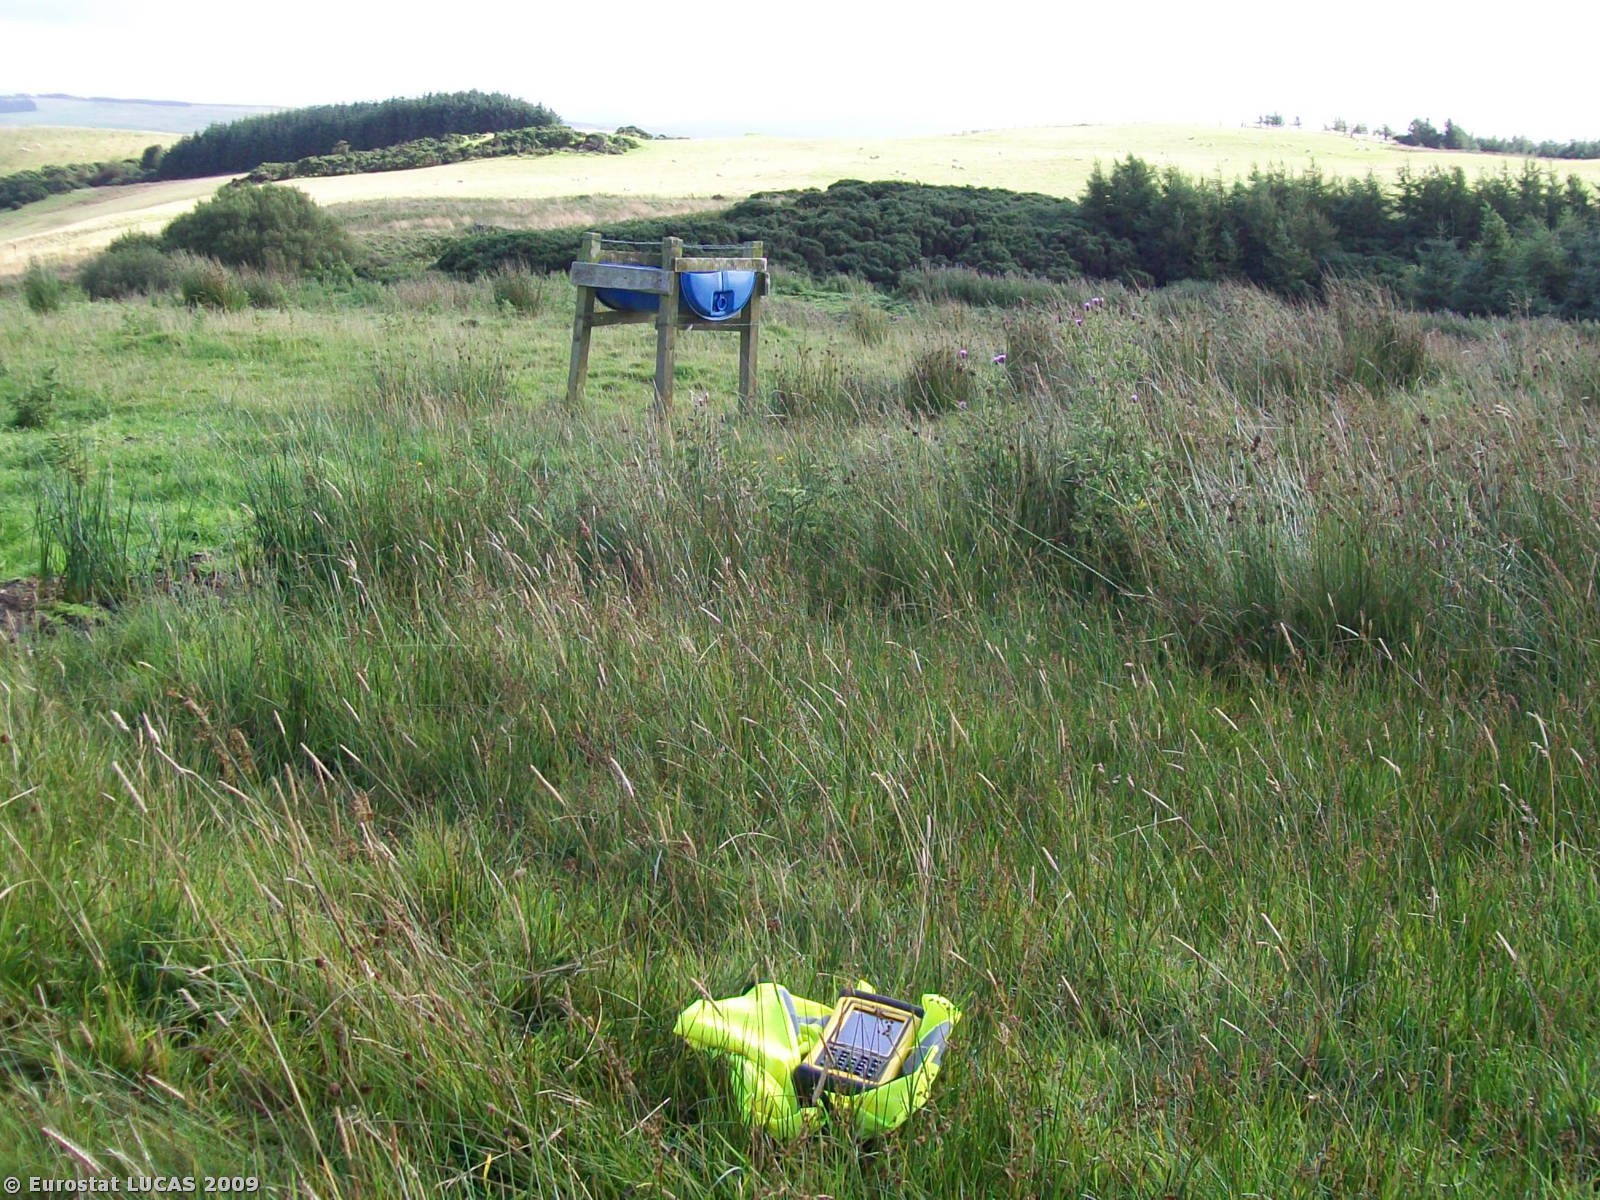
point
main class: Grassland
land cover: Grassland without tree/shrub cover
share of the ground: < 10 %
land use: Agriculture (excluding fallow land and kitchen gardens)
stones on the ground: < 10 %
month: August
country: GB
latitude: 55.1313
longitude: -4.8688
